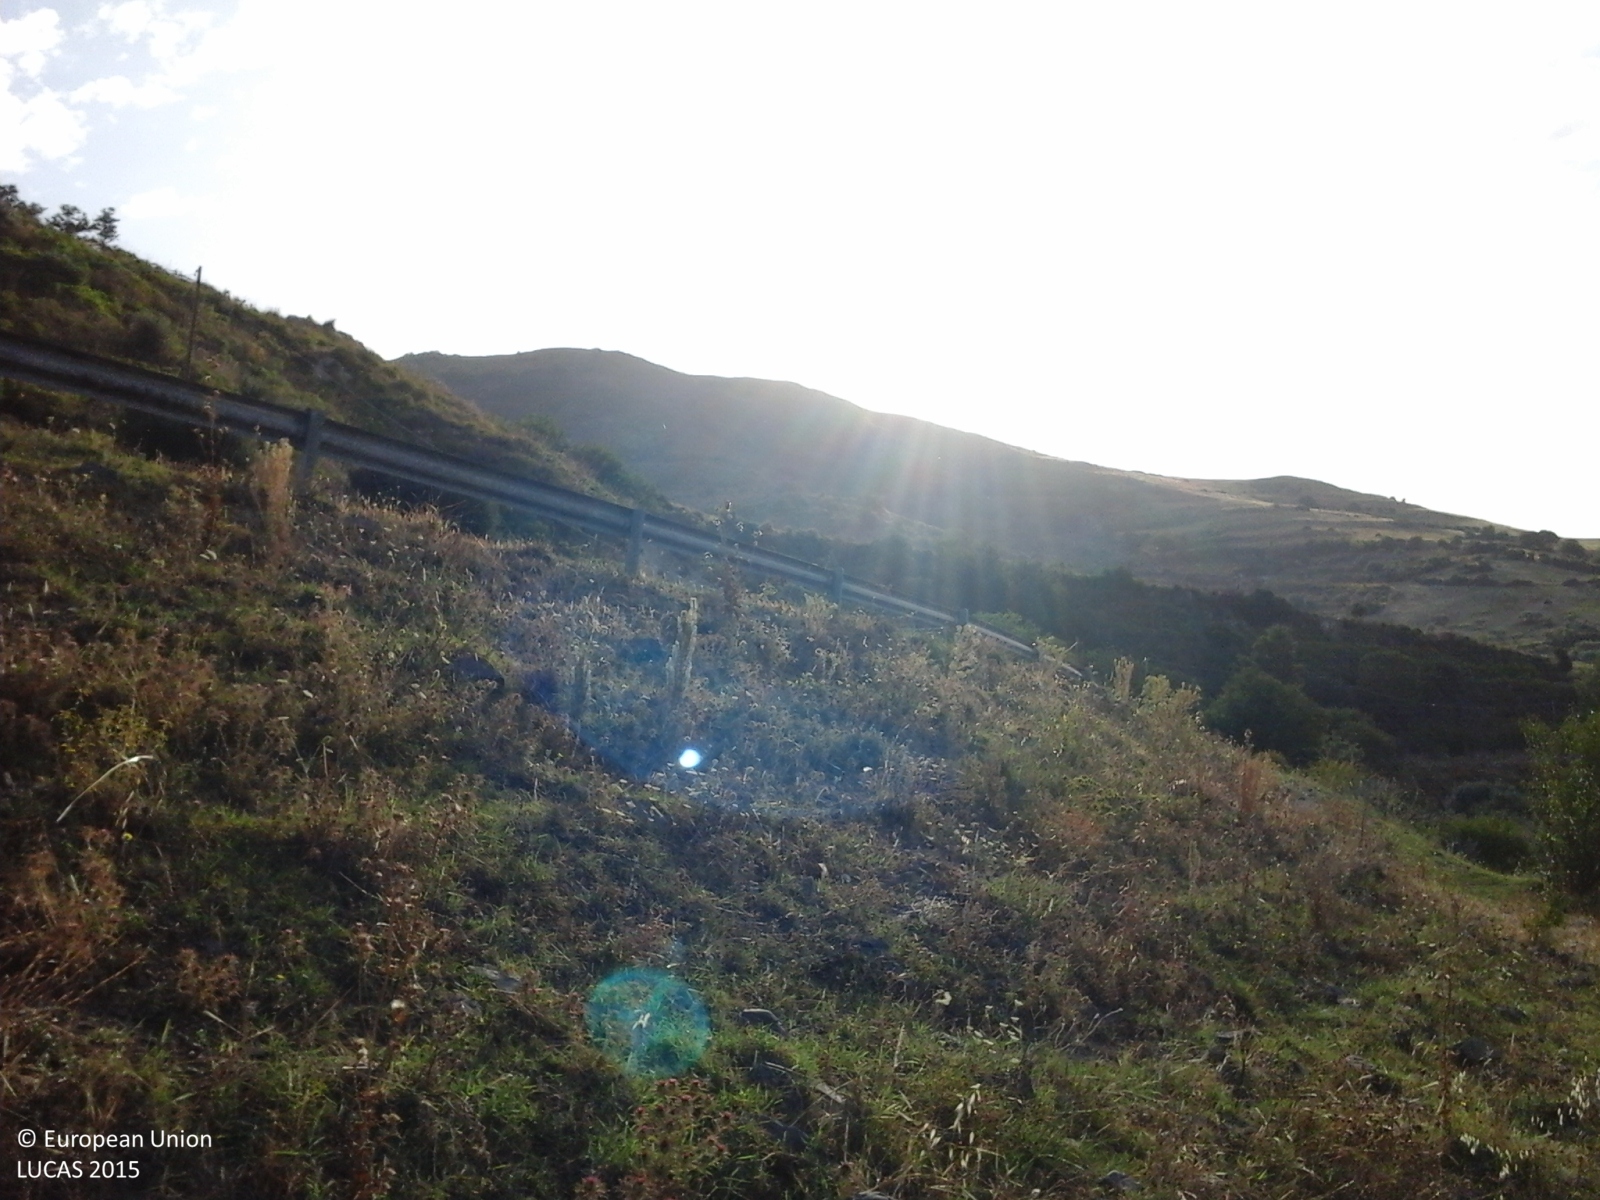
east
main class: Grassland
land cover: Spontaneously vegetated surfaces
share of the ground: 10 - 25 %
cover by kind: unconsolidated bare surface 75 %, herbaceous plants 25 %
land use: Agriculture (excluding fallow land and kitchen gardens)
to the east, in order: Spontaneously vegetated surfaces; Electric lines; Dry stone walls; Grassland without tree/shrub cover; Nuts trees; Grassland without tree/shrub cover; Paved roads, cycling and walking lanes; Dry stone walls; Shrubland with sparse tree cover; Electric lines; Shrubland with sparse tree cover; Tracks; Shrubland with sparse tree cover
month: August
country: IT
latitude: 37.1538
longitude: 14.7937
